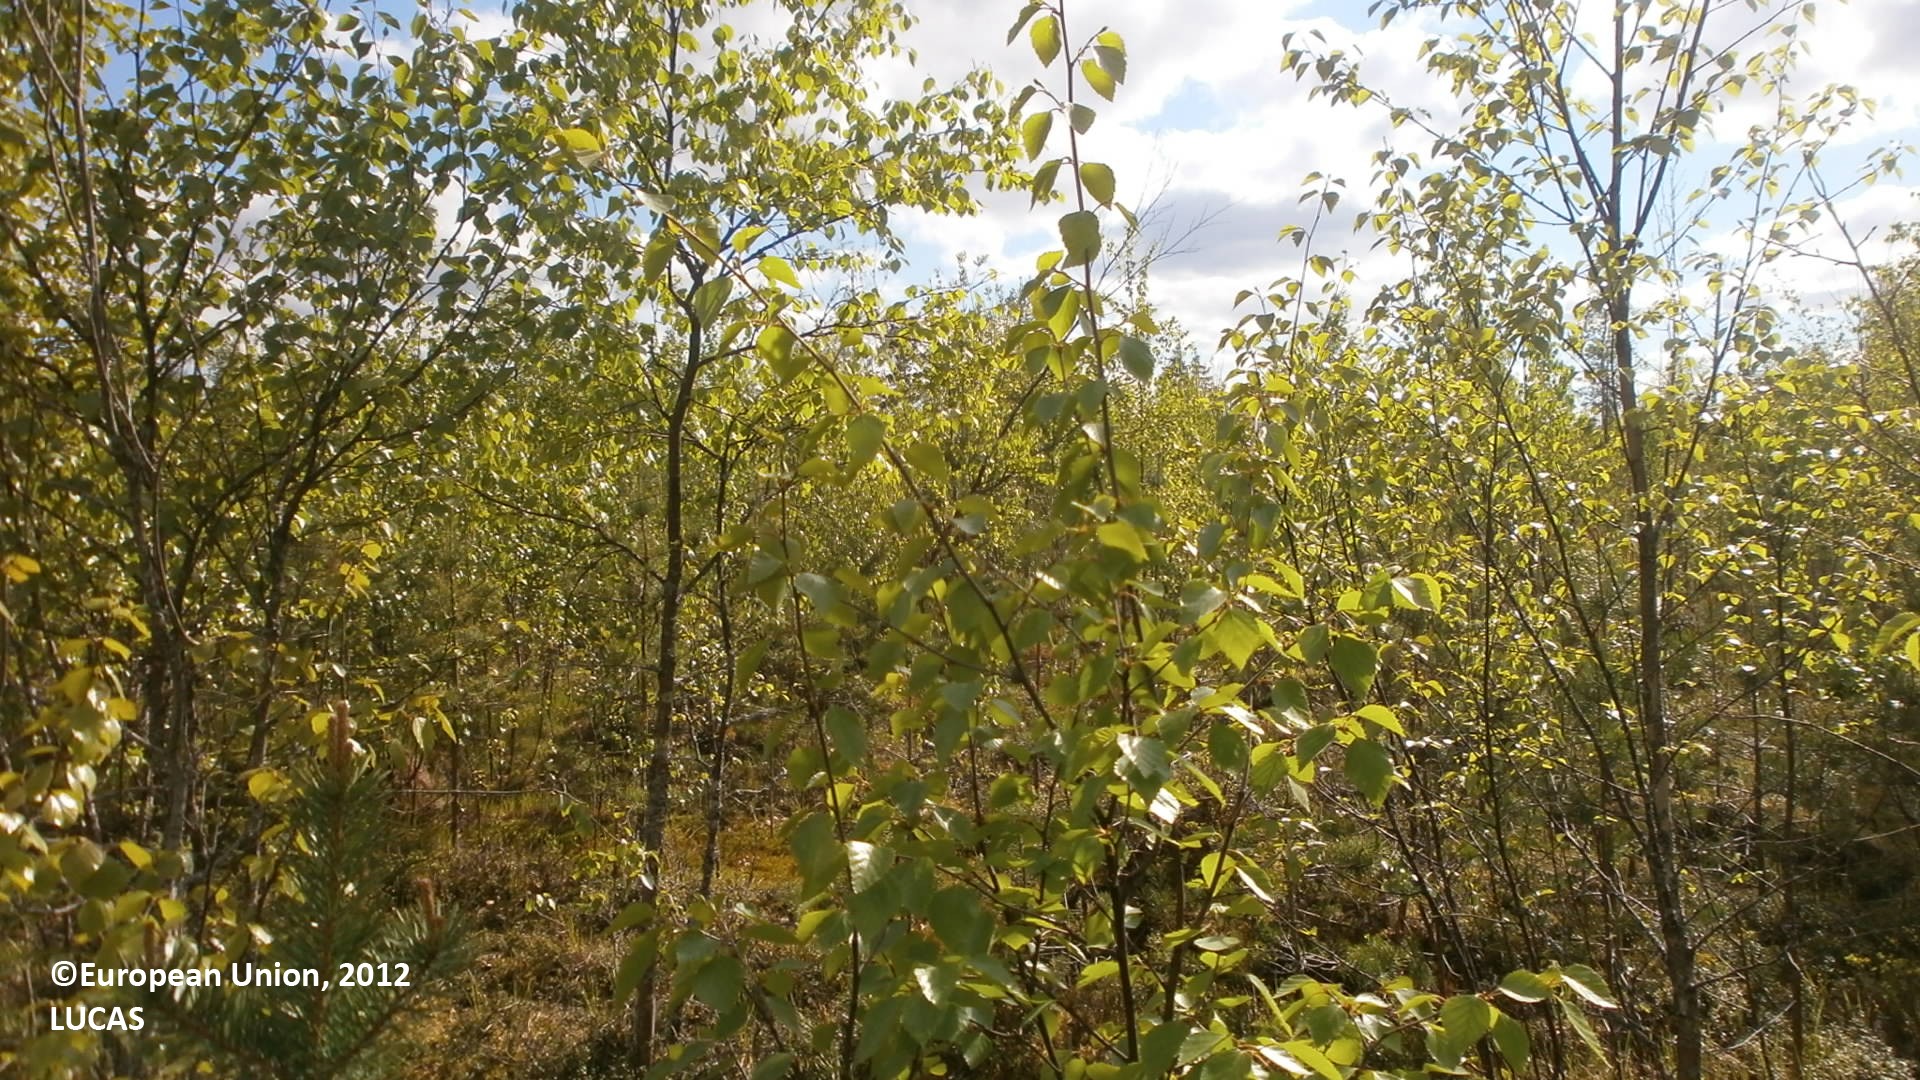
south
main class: Woodland
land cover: Other mixed woodland
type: mire and swamp forests
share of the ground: > 75 %
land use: Forestry
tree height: < 5 m
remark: Clear cut
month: June
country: FI
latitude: 64.5112
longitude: 25.1824
